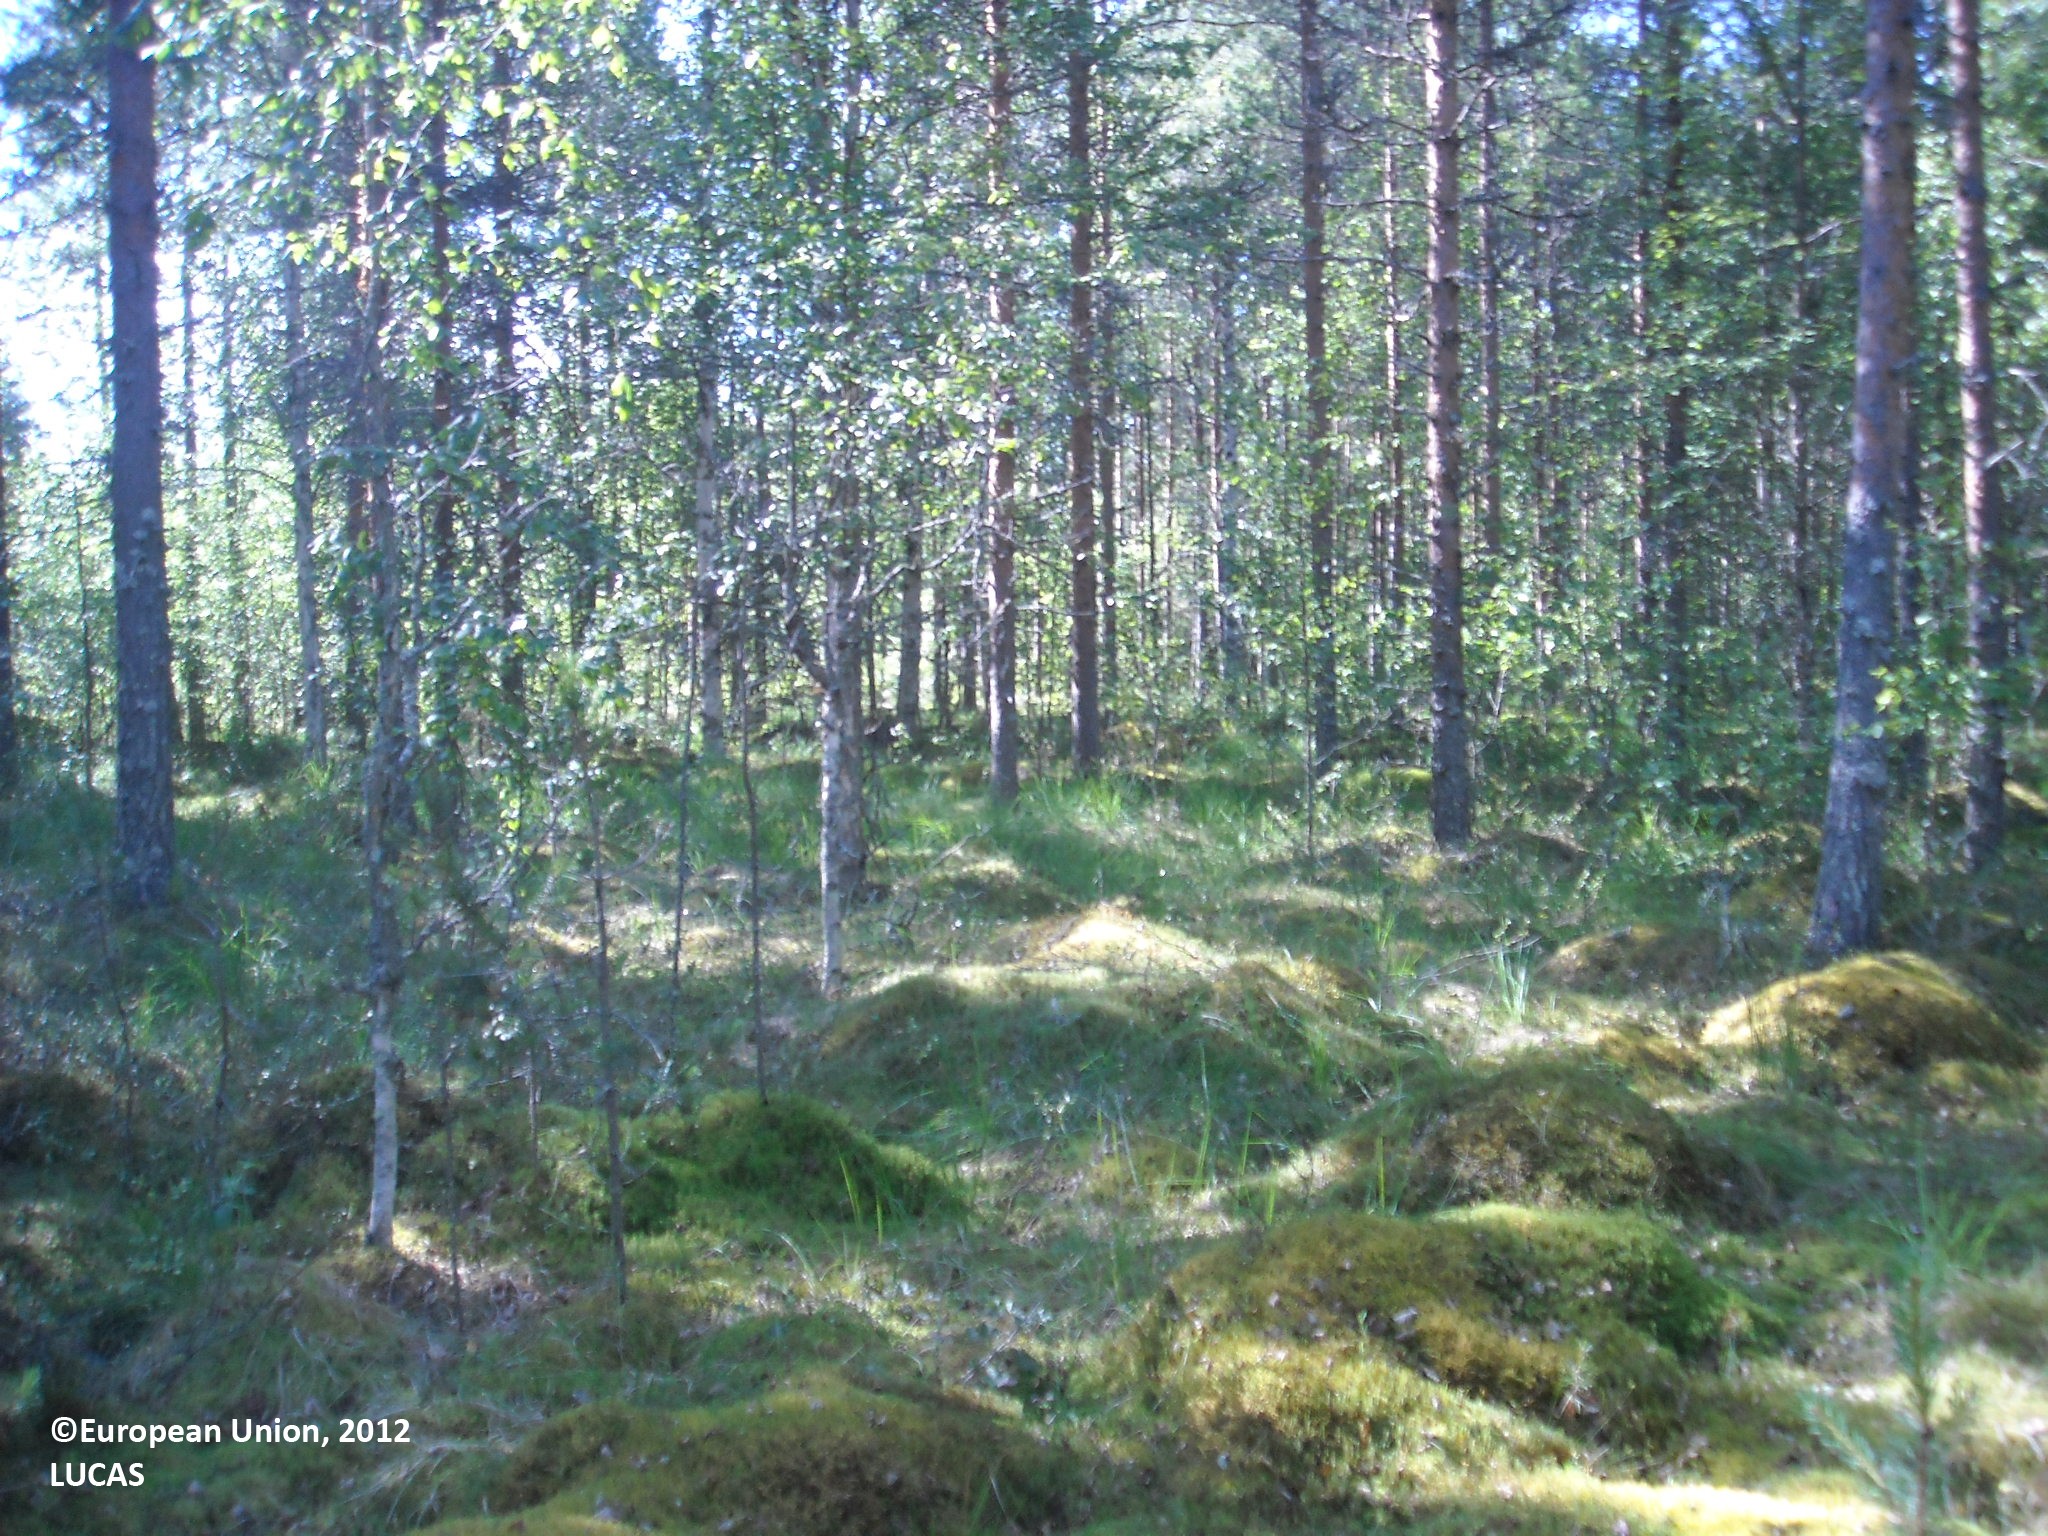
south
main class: Woodland
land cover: Pine dominated mixed woodland
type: mire and swamp forests
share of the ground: > 75 %
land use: Forestry
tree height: > 5 m
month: July
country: FI
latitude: 65.0695
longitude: 27.5066
